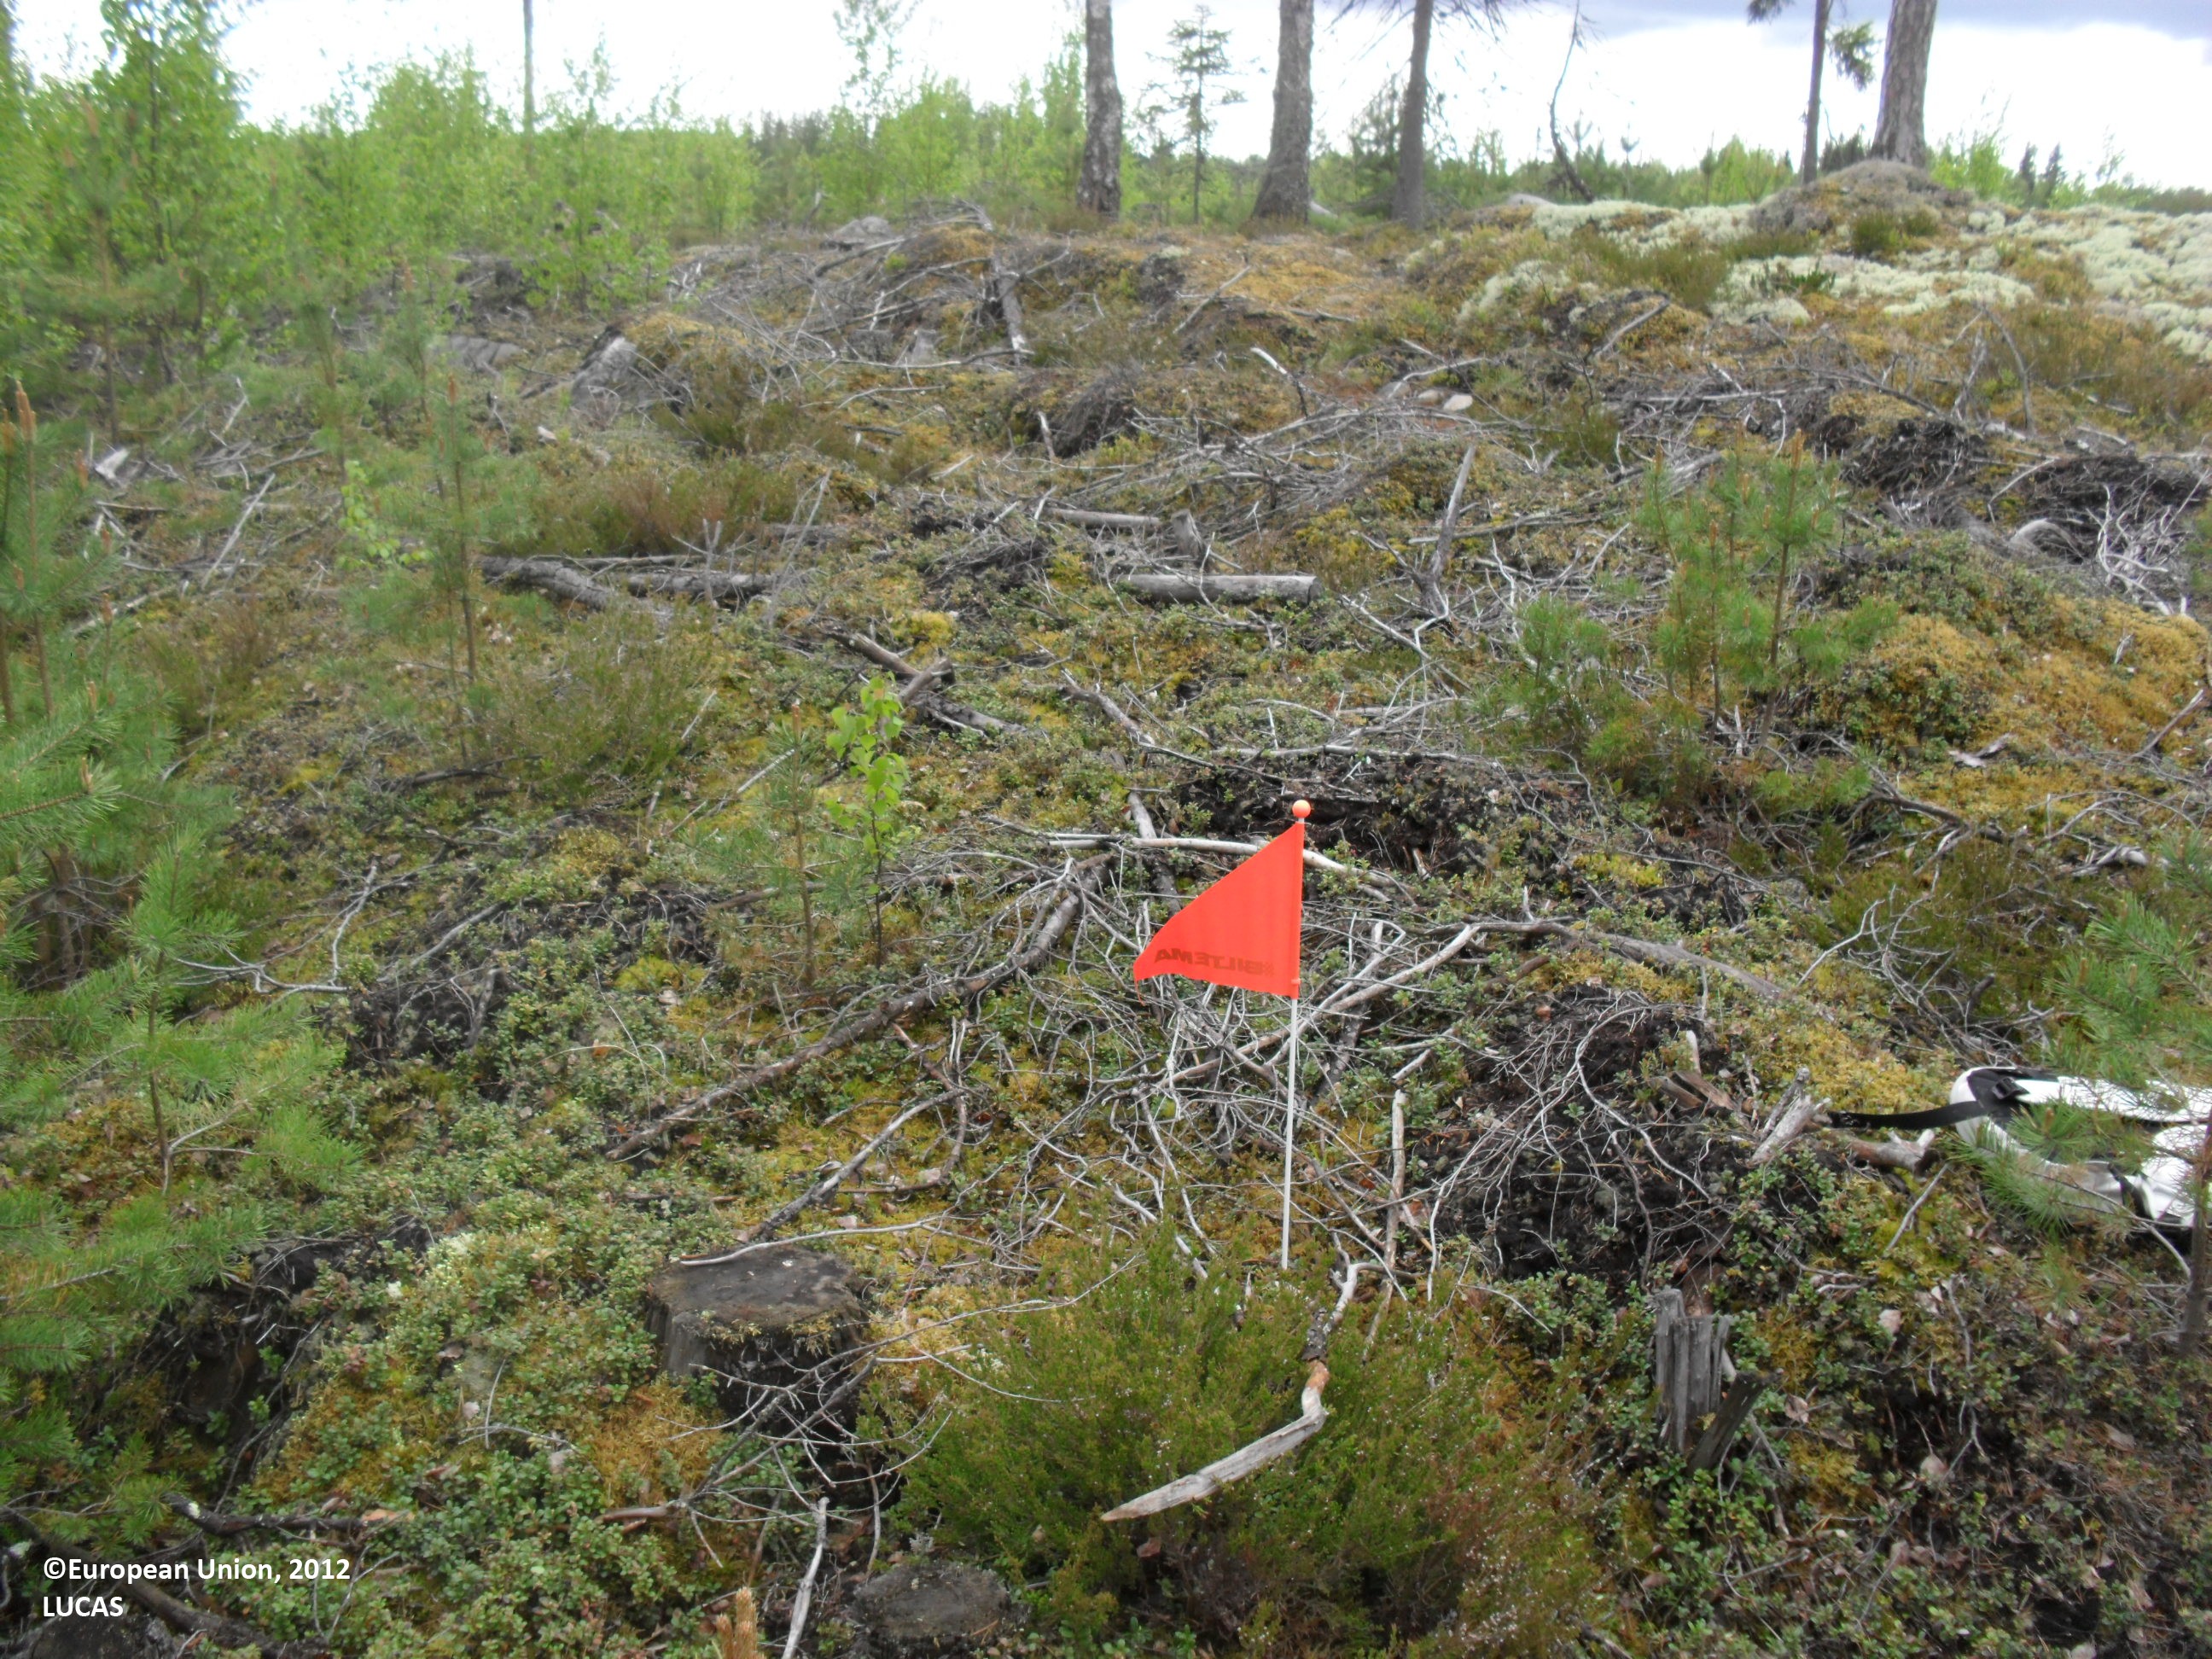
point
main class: Woodland
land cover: Pine dominated mixed woodland
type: boreal forest
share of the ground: < 10 %
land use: Forestry
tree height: < 5 m
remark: Clear cut
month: June
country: FI
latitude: 62.9156
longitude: 23.1136
